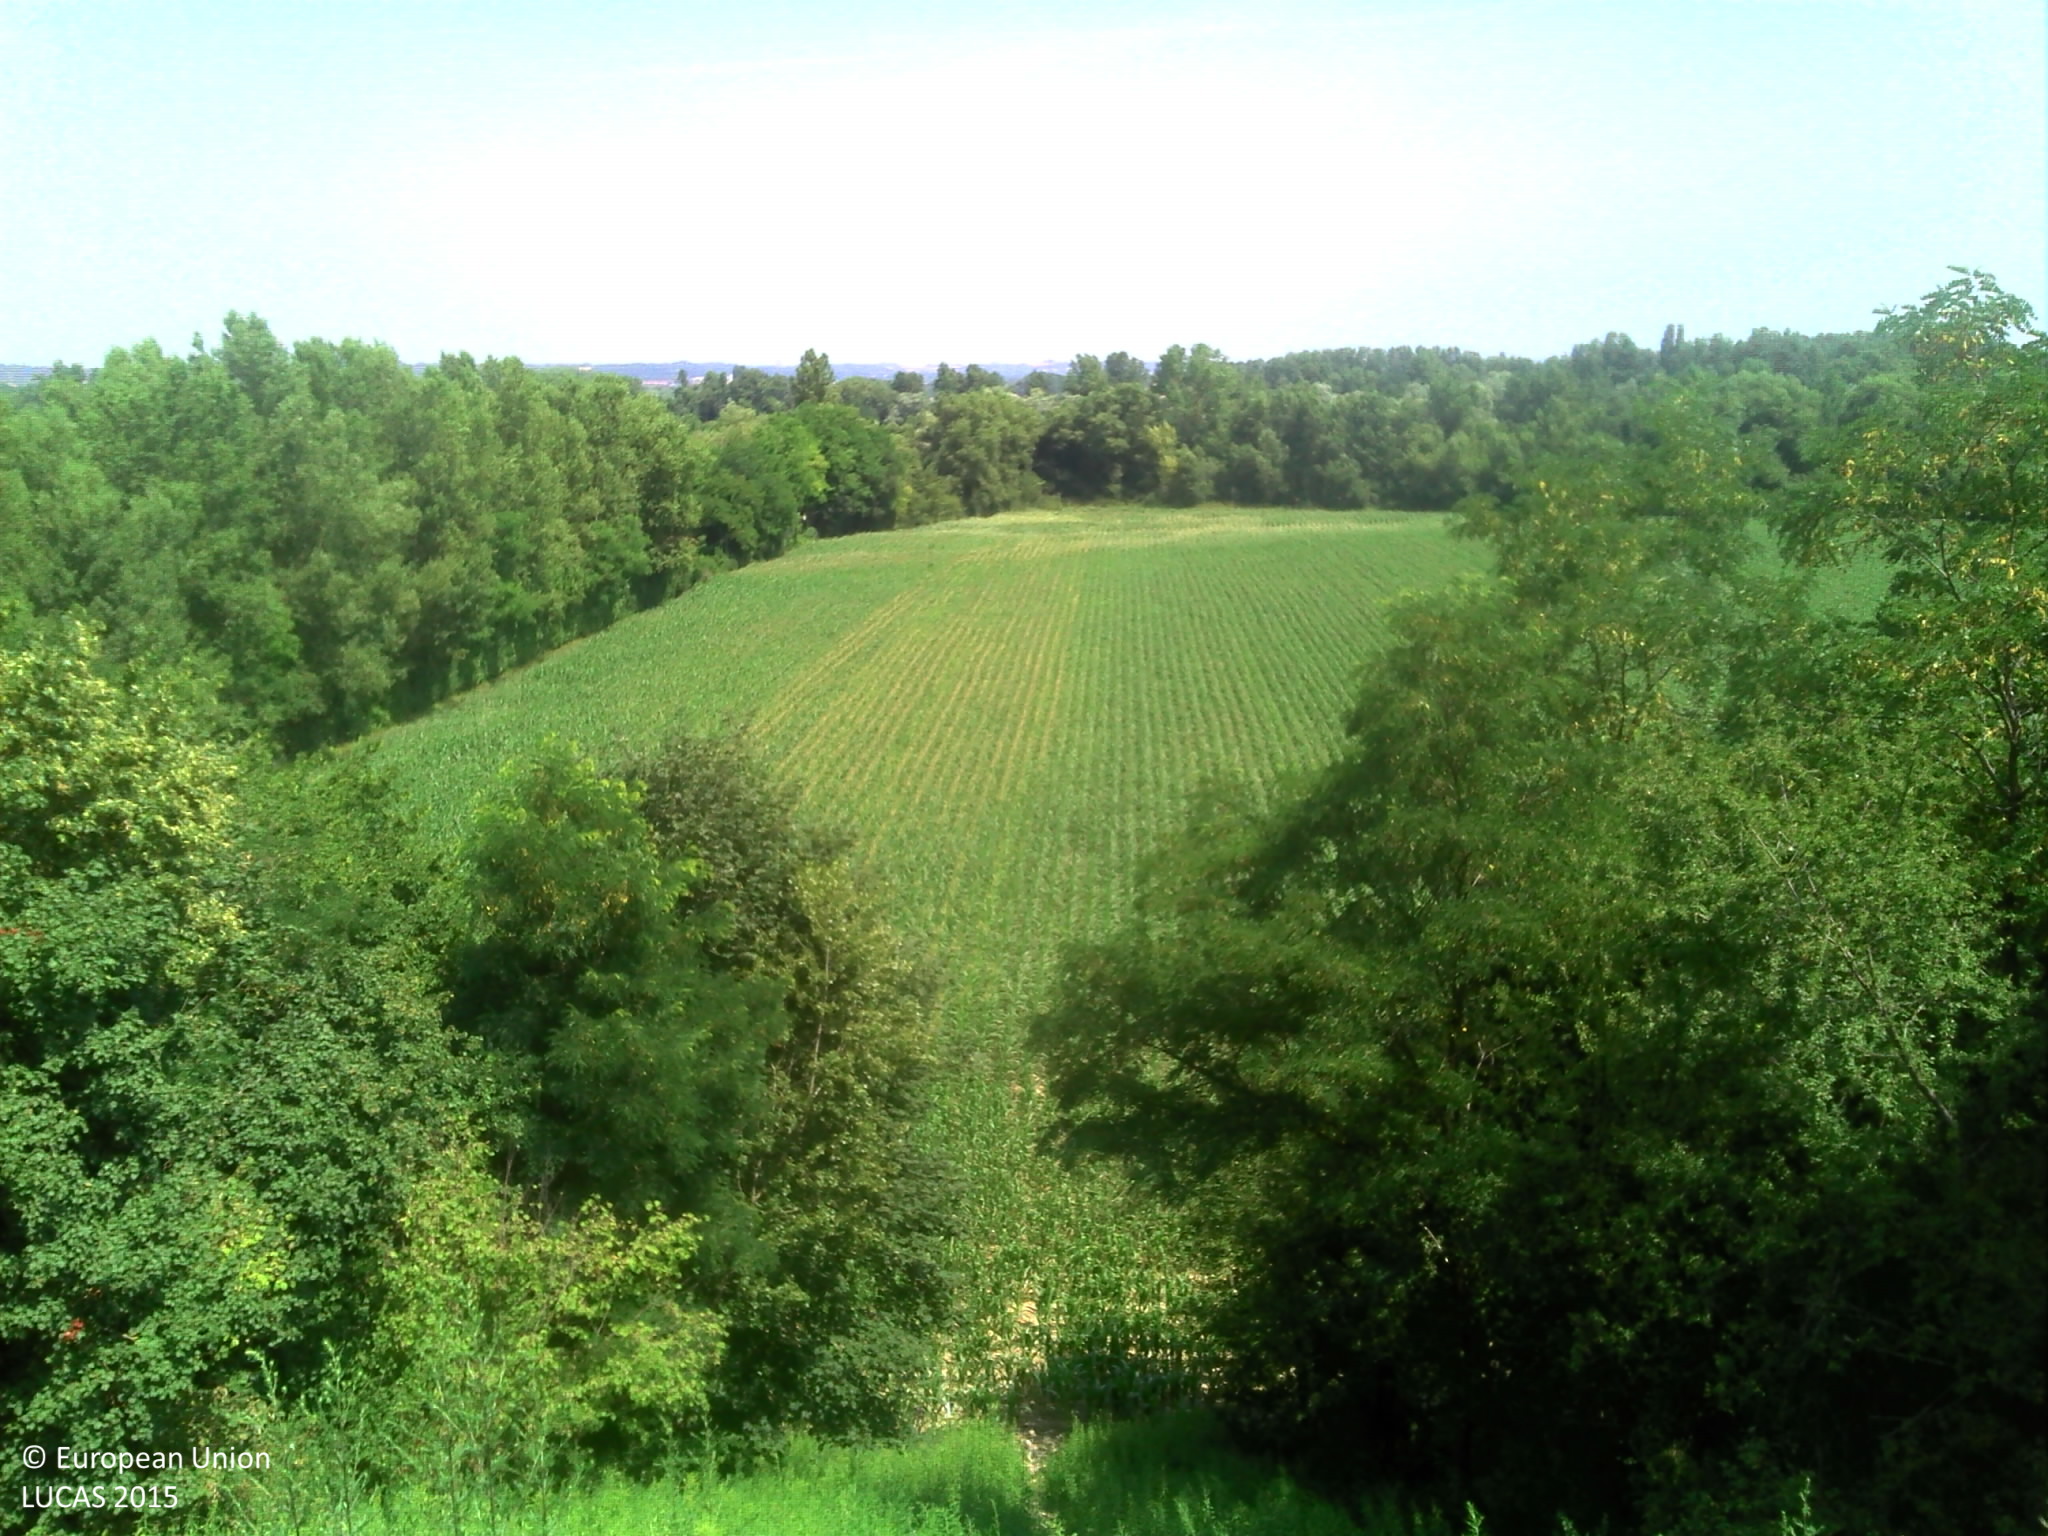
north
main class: Cropland
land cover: Maize
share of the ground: 50 - 75 %
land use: Agriculture (excluding fallow land and kitchen gardens)
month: July
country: FR
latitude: 45.8071
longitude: 5.1269
